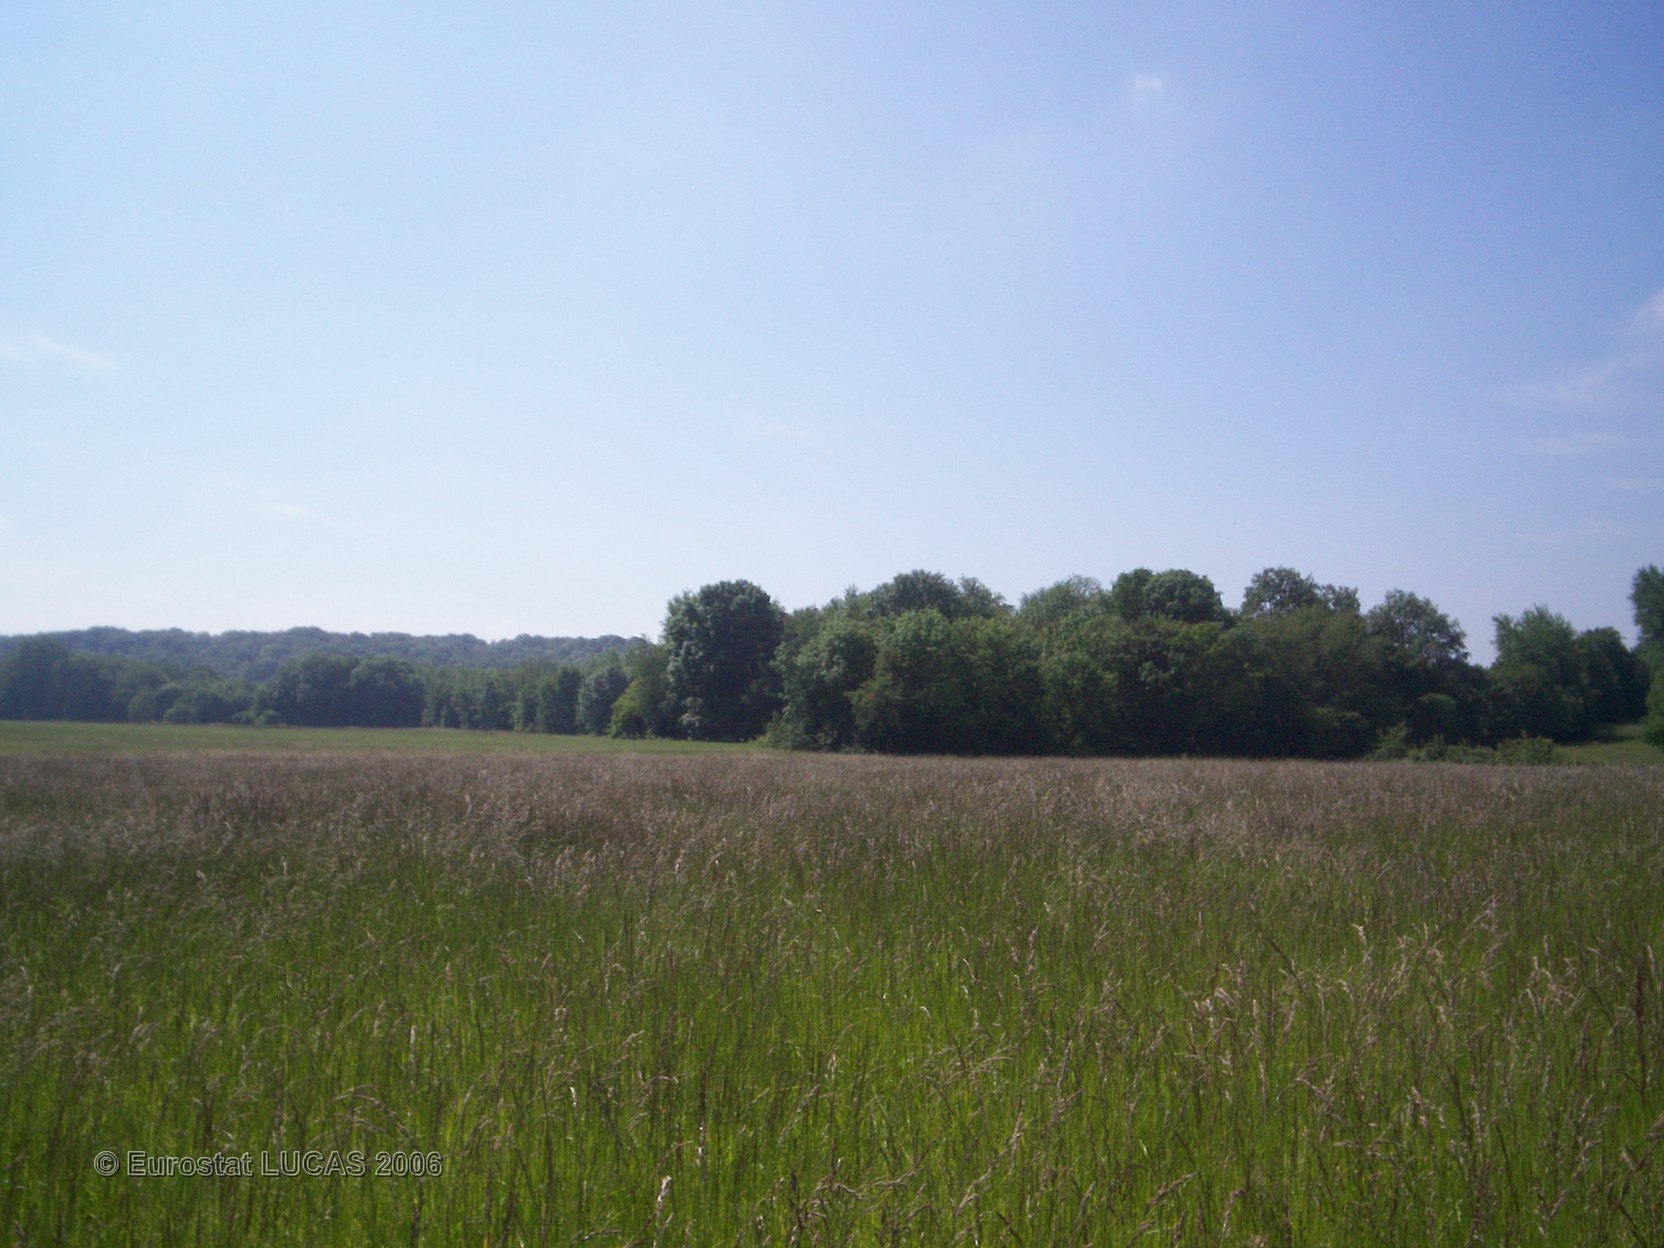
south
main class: Grassland
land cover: Grassland without tree/shrub cover
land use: Agriculture (excluding fallow land and kitchen gardens)
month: June
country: FR
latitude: 49.6247
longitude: 2.6935
